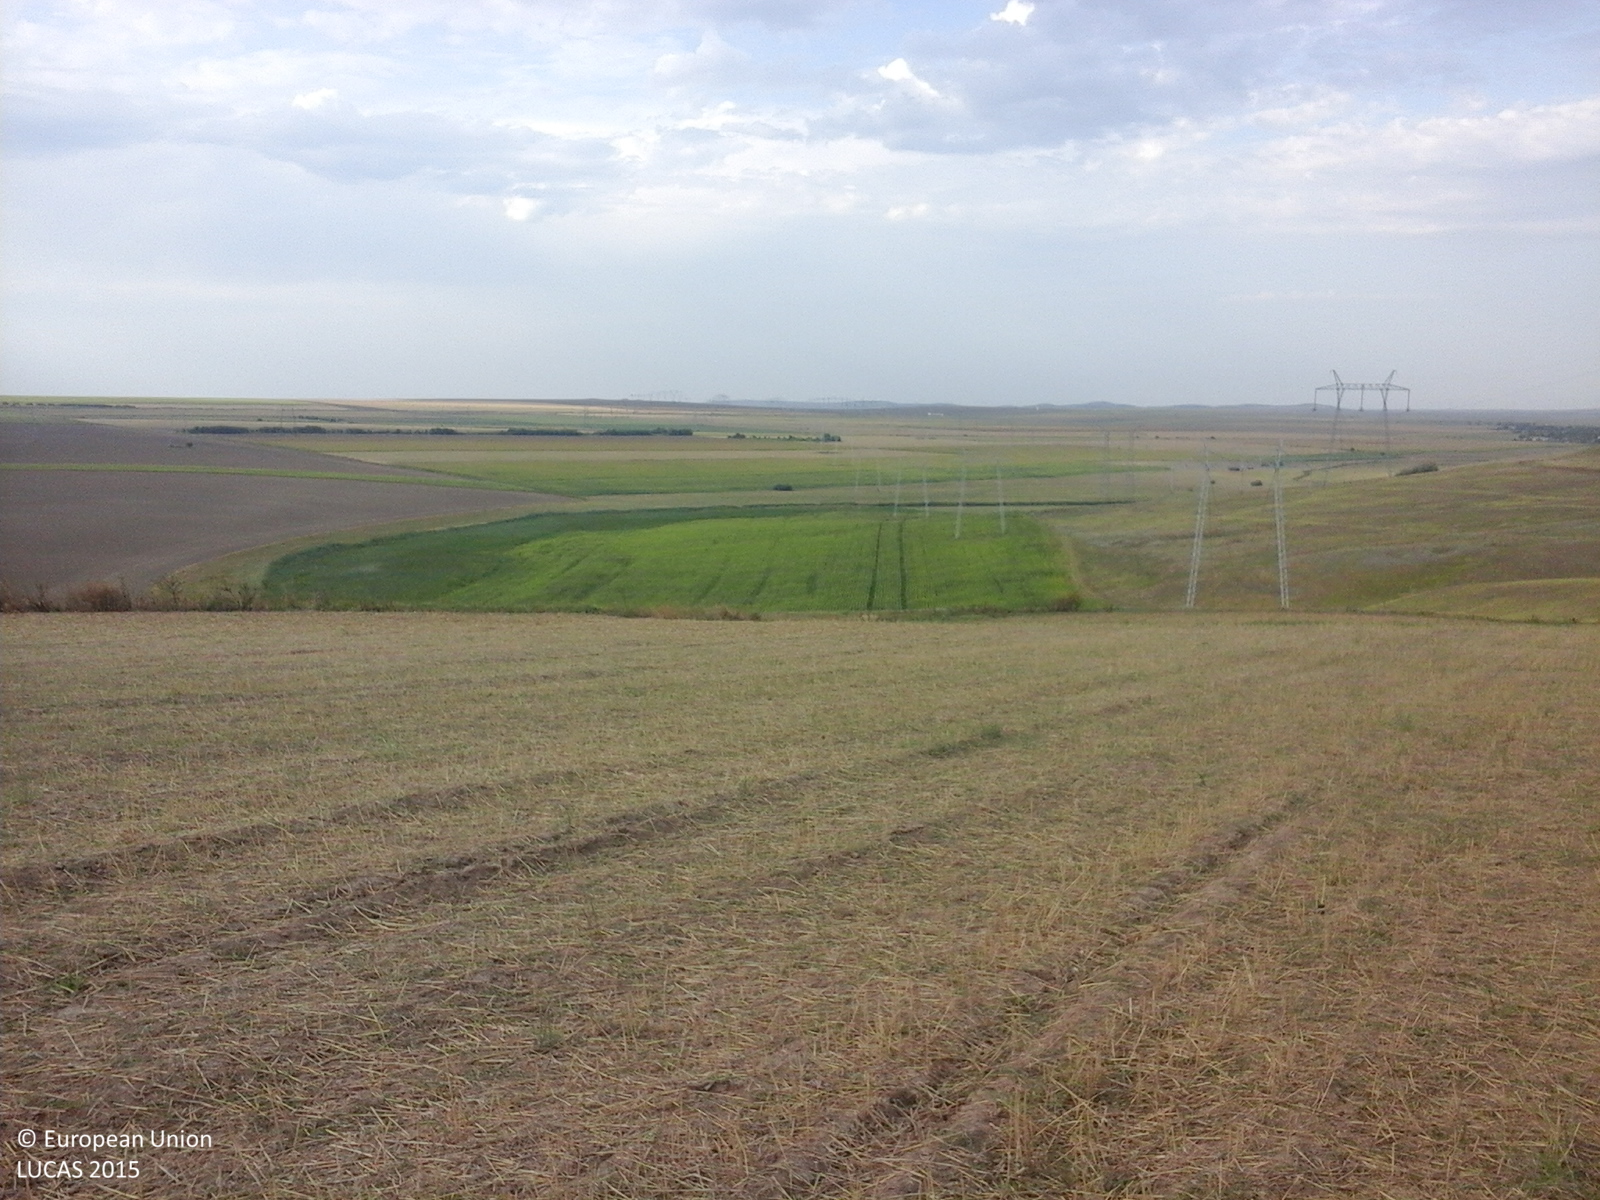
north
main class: Cropland
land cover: Common wheat
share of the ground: 25 - 50 %
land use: Agriculture (excluding fallow land and kitchen gardens)
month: August
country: RO
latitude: 44.3763
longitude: 28.1458
